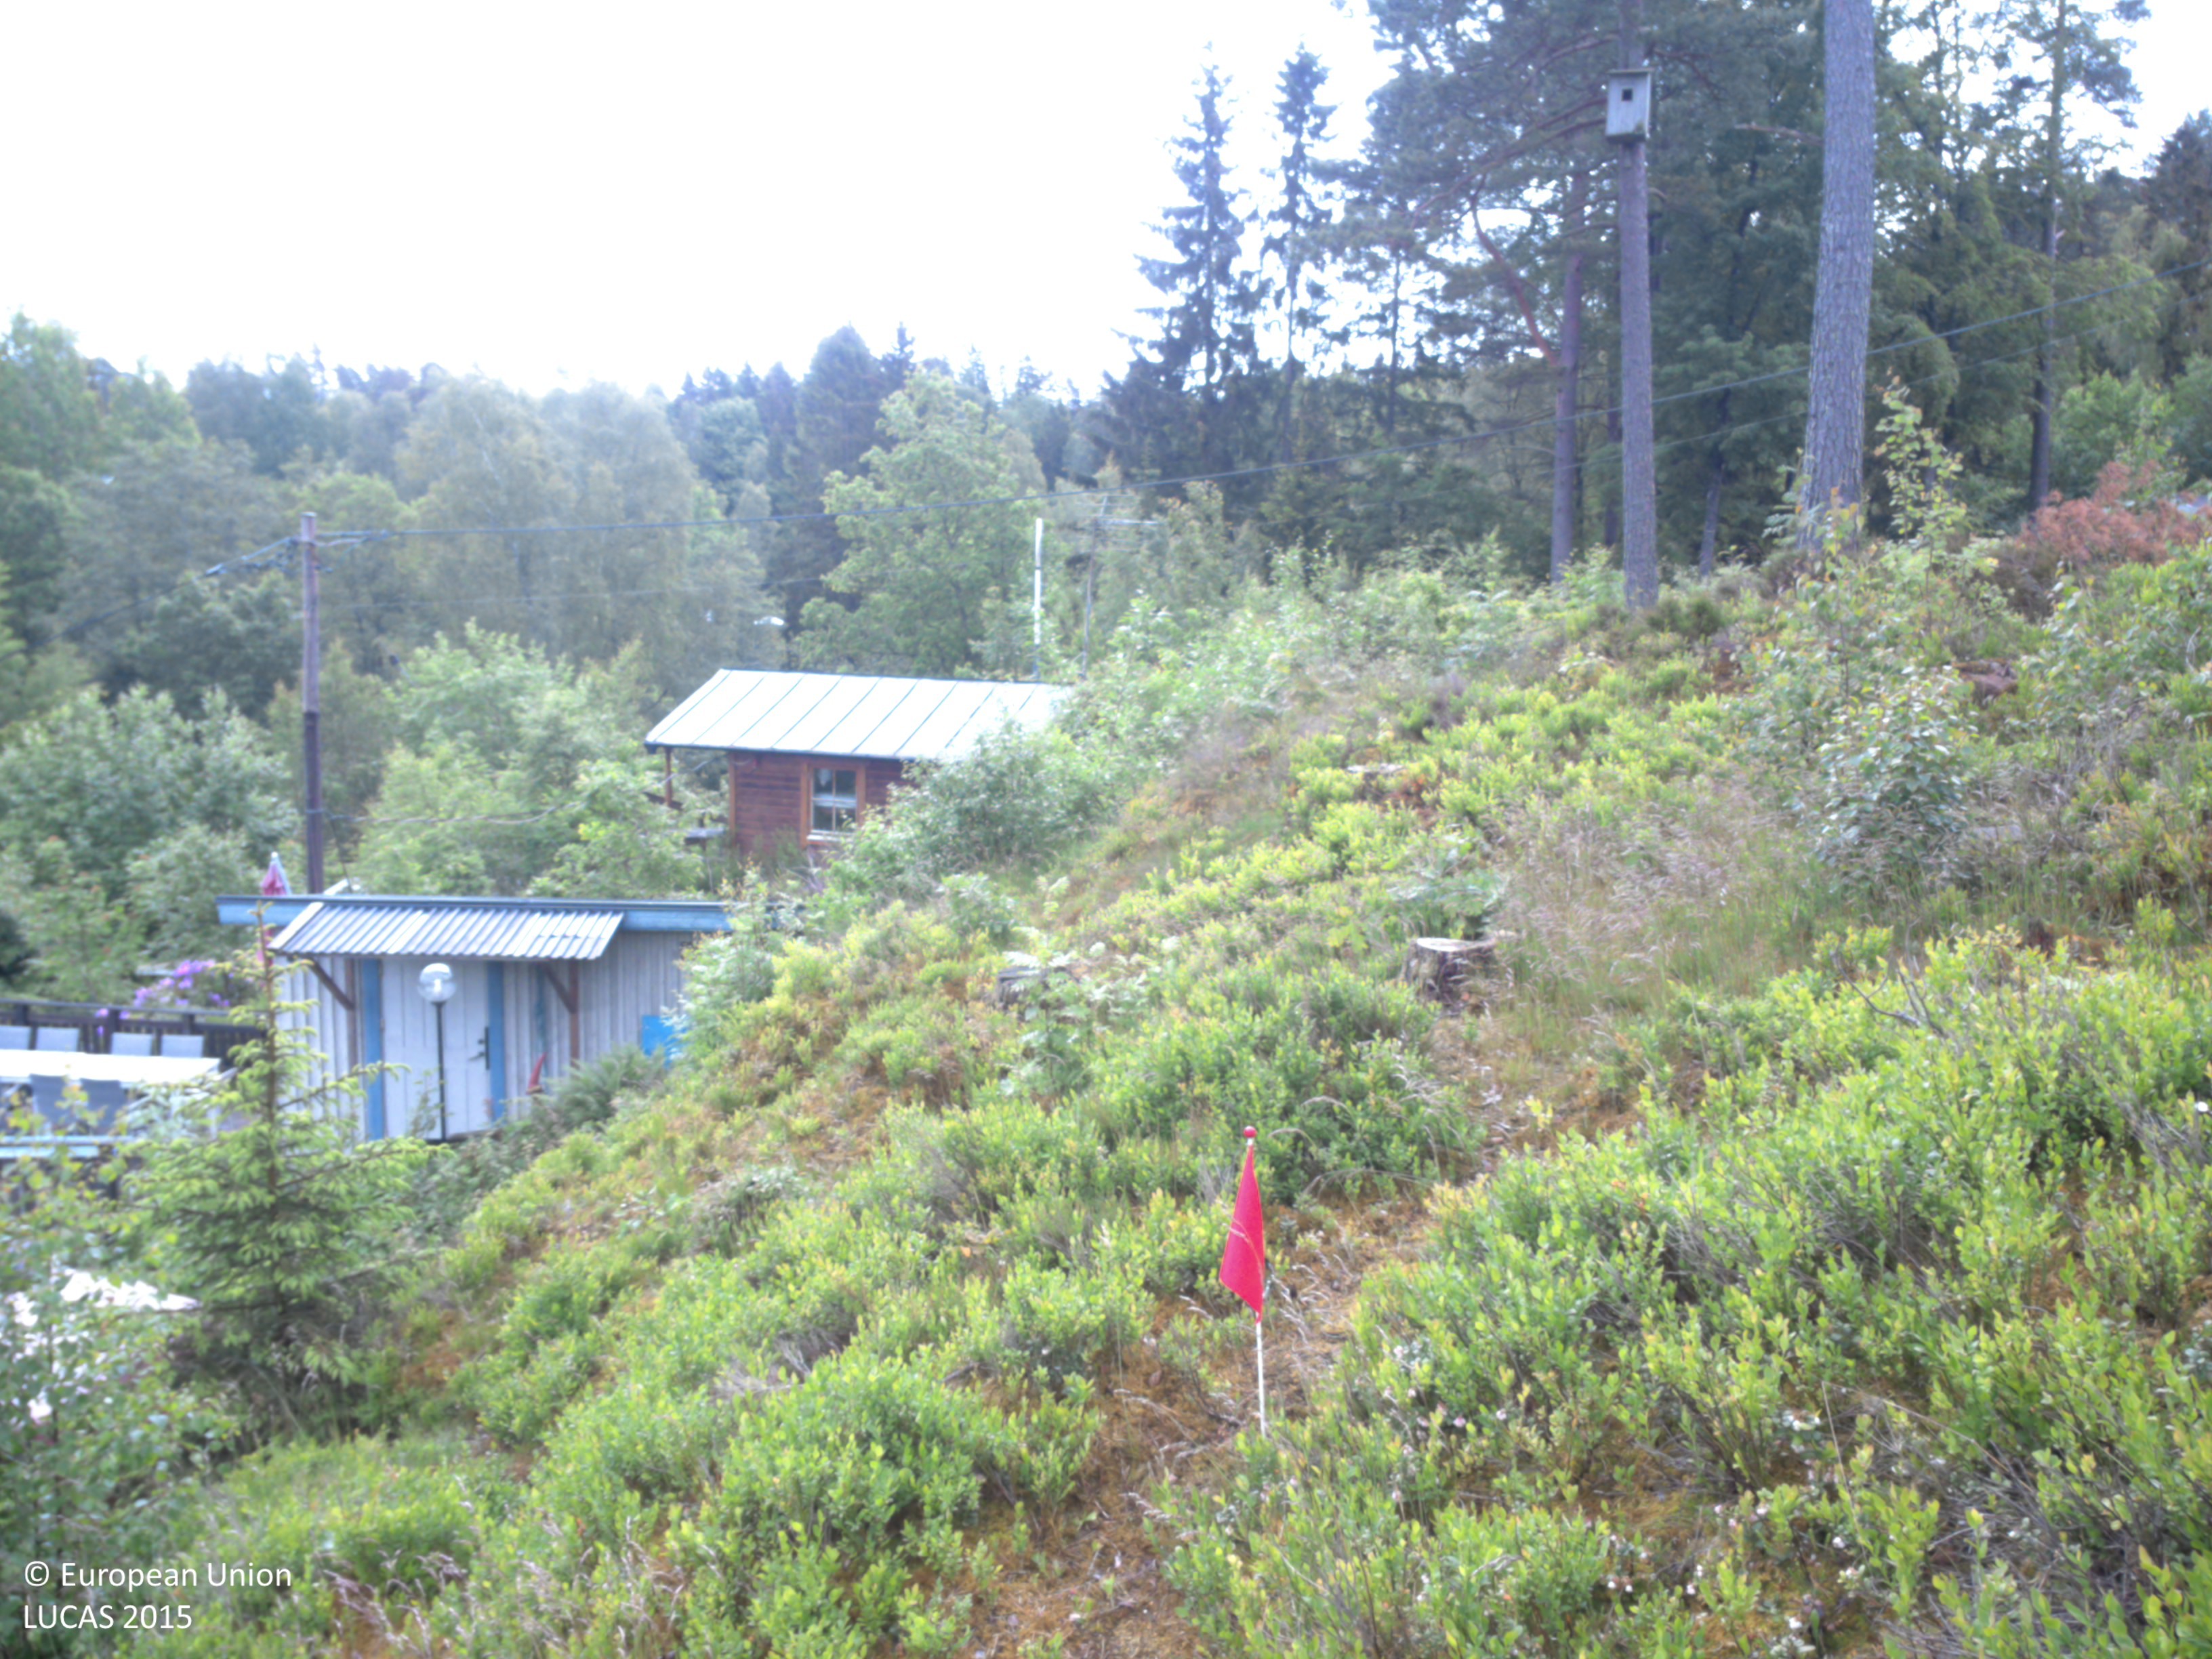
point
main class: Woodland
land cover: Pine dominated coniferous woodland
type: boreal forest
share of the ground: < 10 %
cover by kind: shrubs 80 %, coniferous forest trees 10 %, herbaceous plants 5 %, lichens and mosses 5 %
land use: Amenities, museums, leisure
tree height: > 5 m
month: June
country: SE
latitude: 58.4247
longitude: 11.6916
